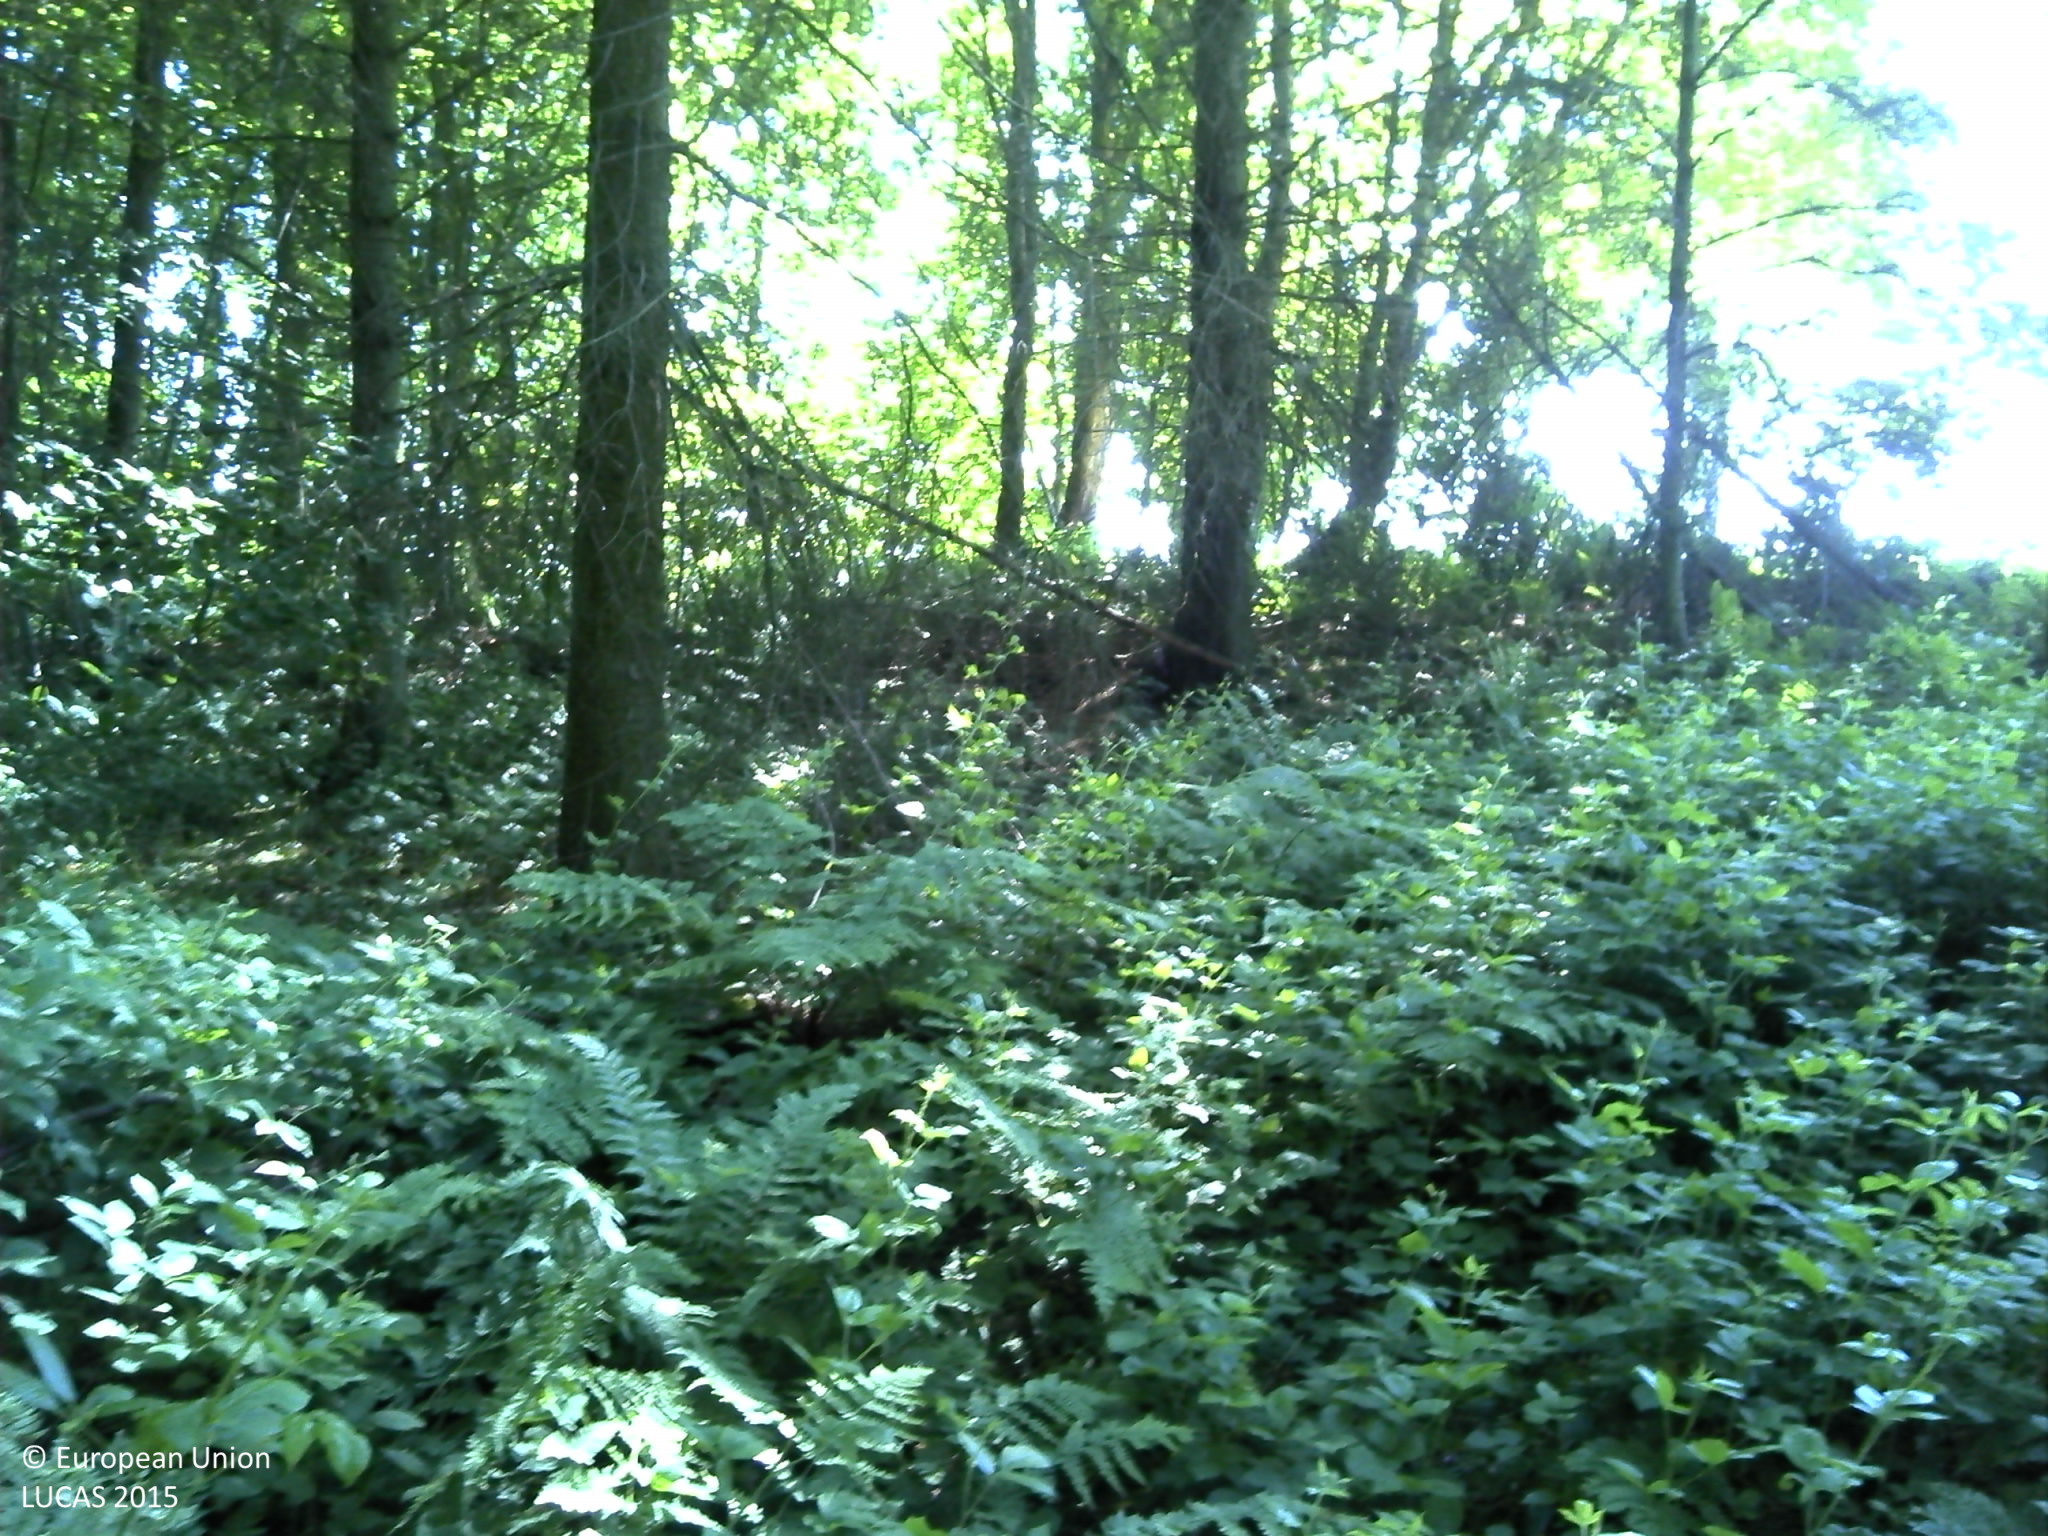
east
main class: Woodland
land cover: Spruce dominated mixed woodland
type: beech forest
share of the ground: > 75 %
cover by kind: coniferous forest trees 45 %, broadleaved forest trees 45 %, herbaceous plants 10 %
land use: Forestry
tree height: > 5 m
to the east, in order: Spruce dominated mixed woodland; Fences; Grassland without tree/shrub cover; Fences; Common wheat; Fences; Grassland without tree/shrub cover
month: June
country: FR
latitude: 49.5633
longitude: 1.0883
